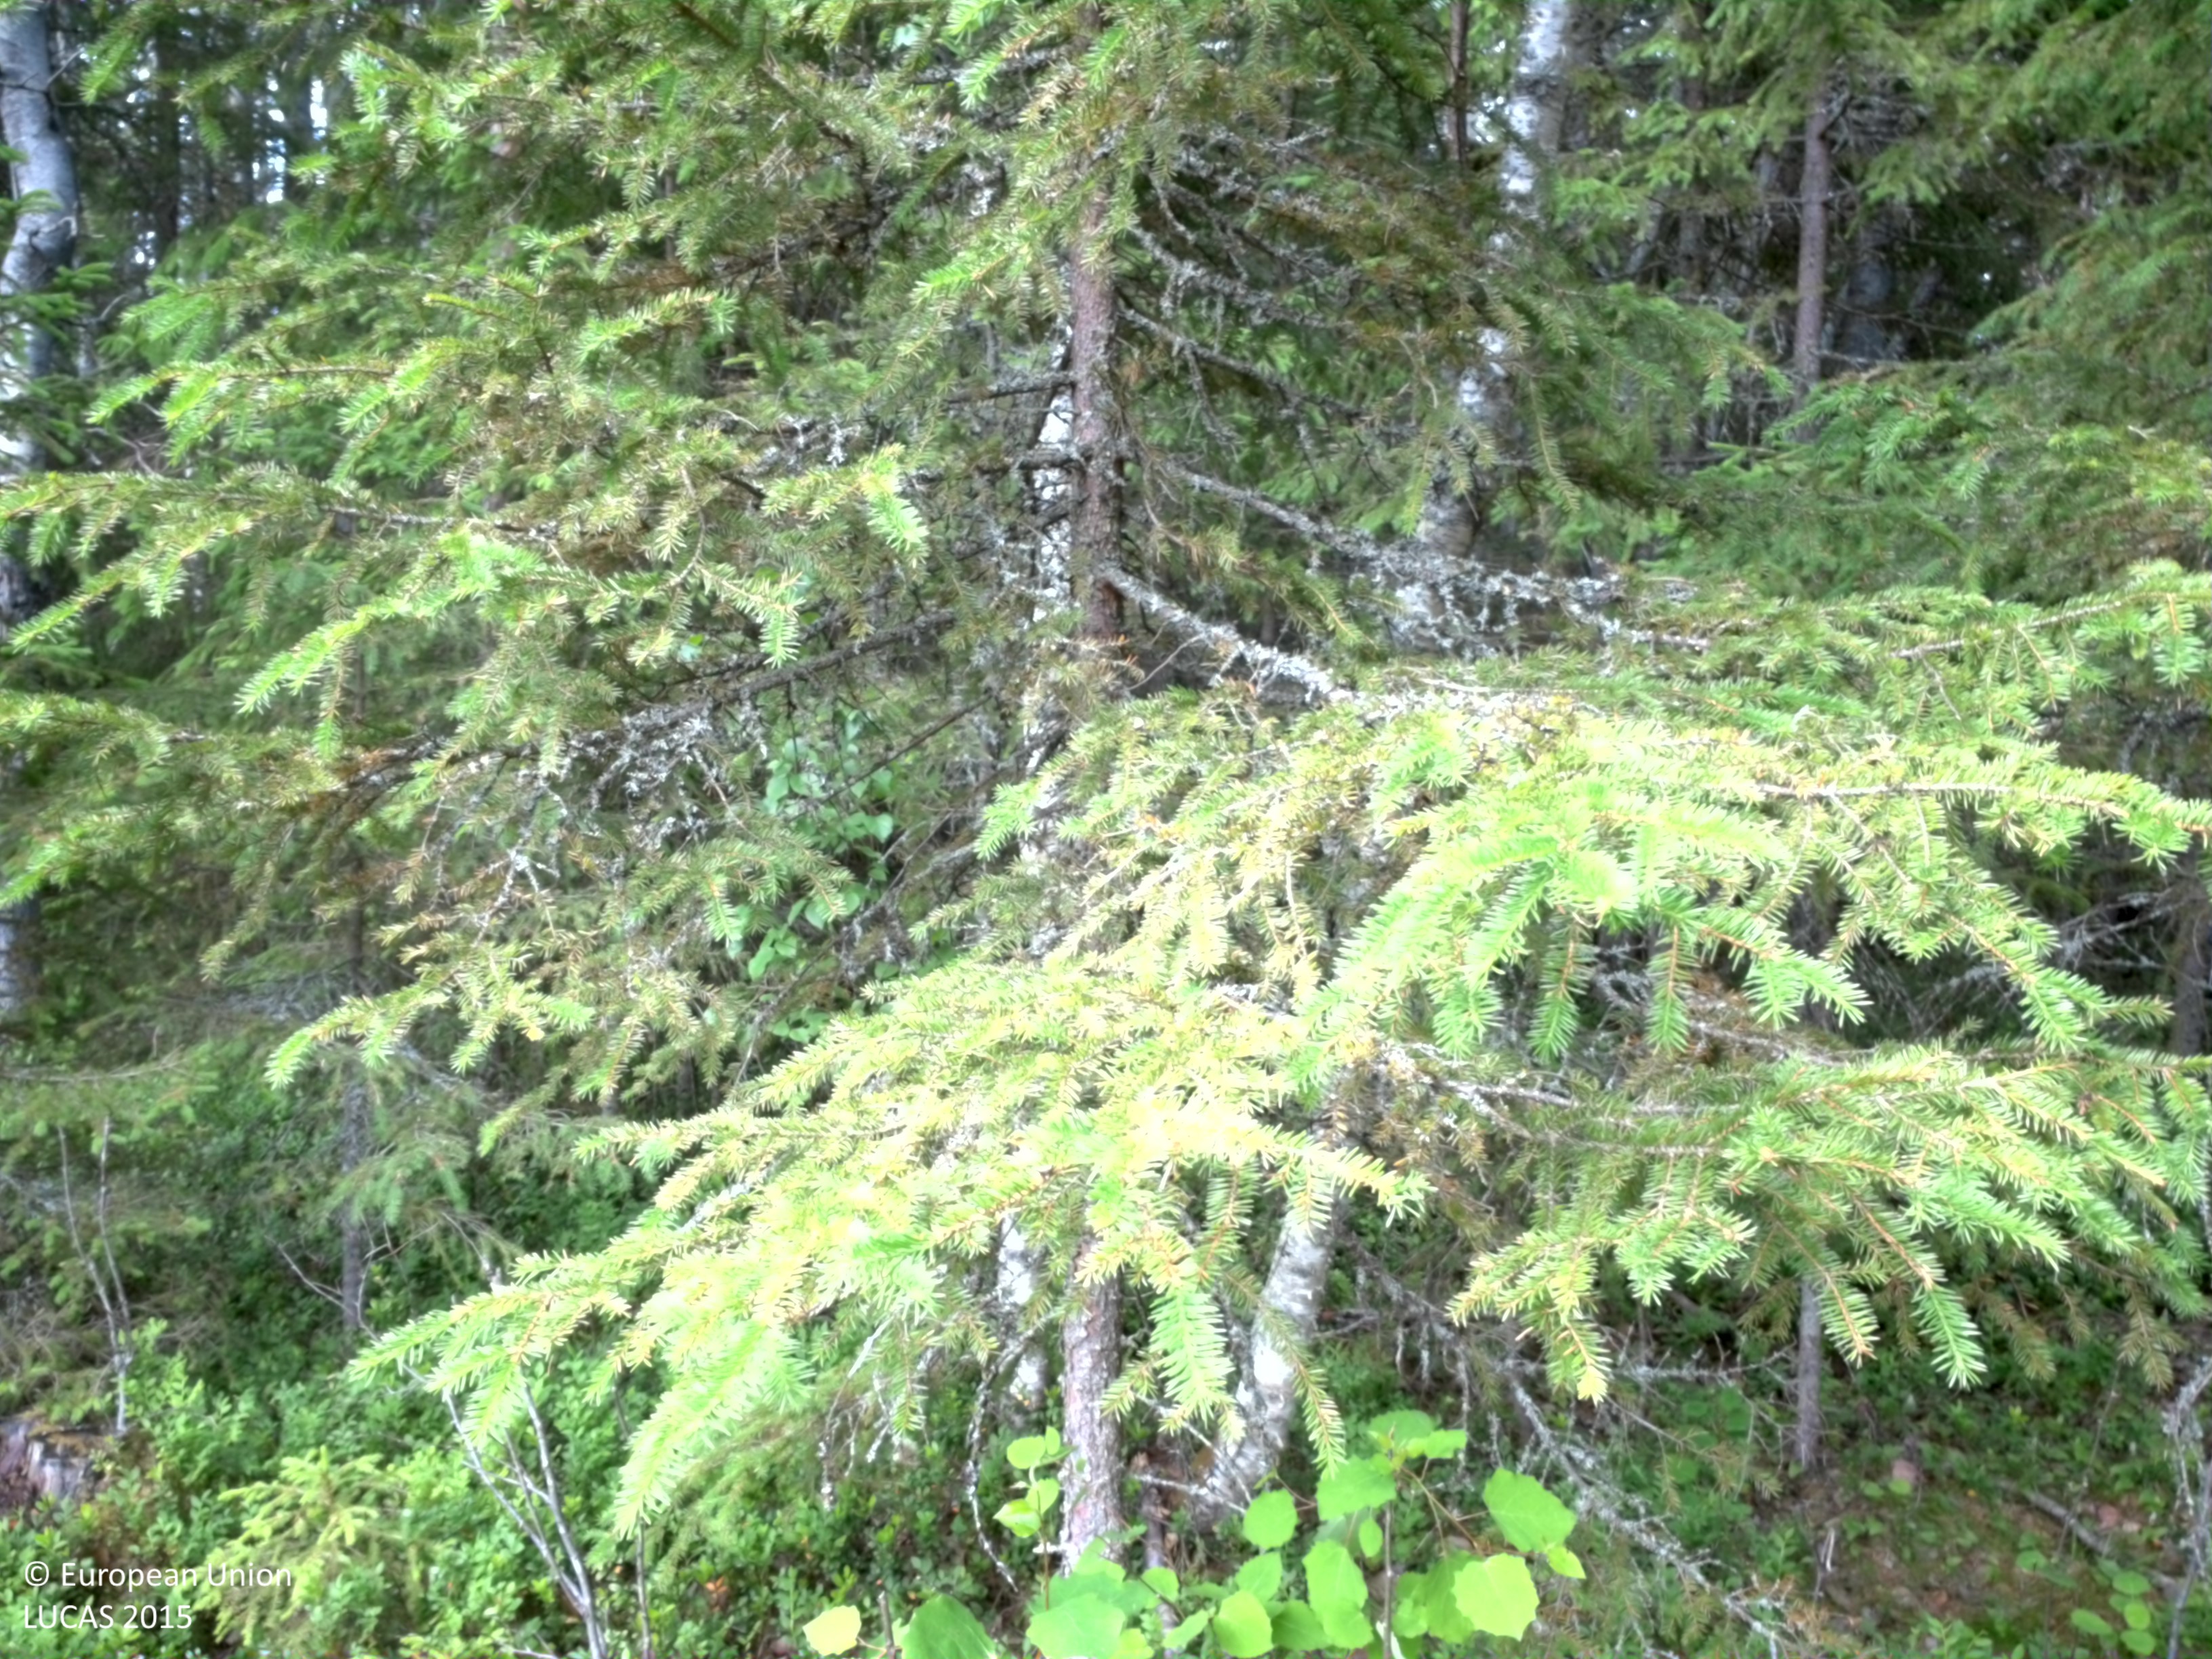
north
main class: Woodland
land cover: Other mixed woodland
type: boreal forest
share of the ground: > 75 %
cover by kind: coniferous forest trees 60 %, broadleaved forest trees 20 %, shrubs 20 %
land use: Forestry
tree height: > 5 m
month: July
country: SE
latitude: 64.4072
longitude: 20.8736
